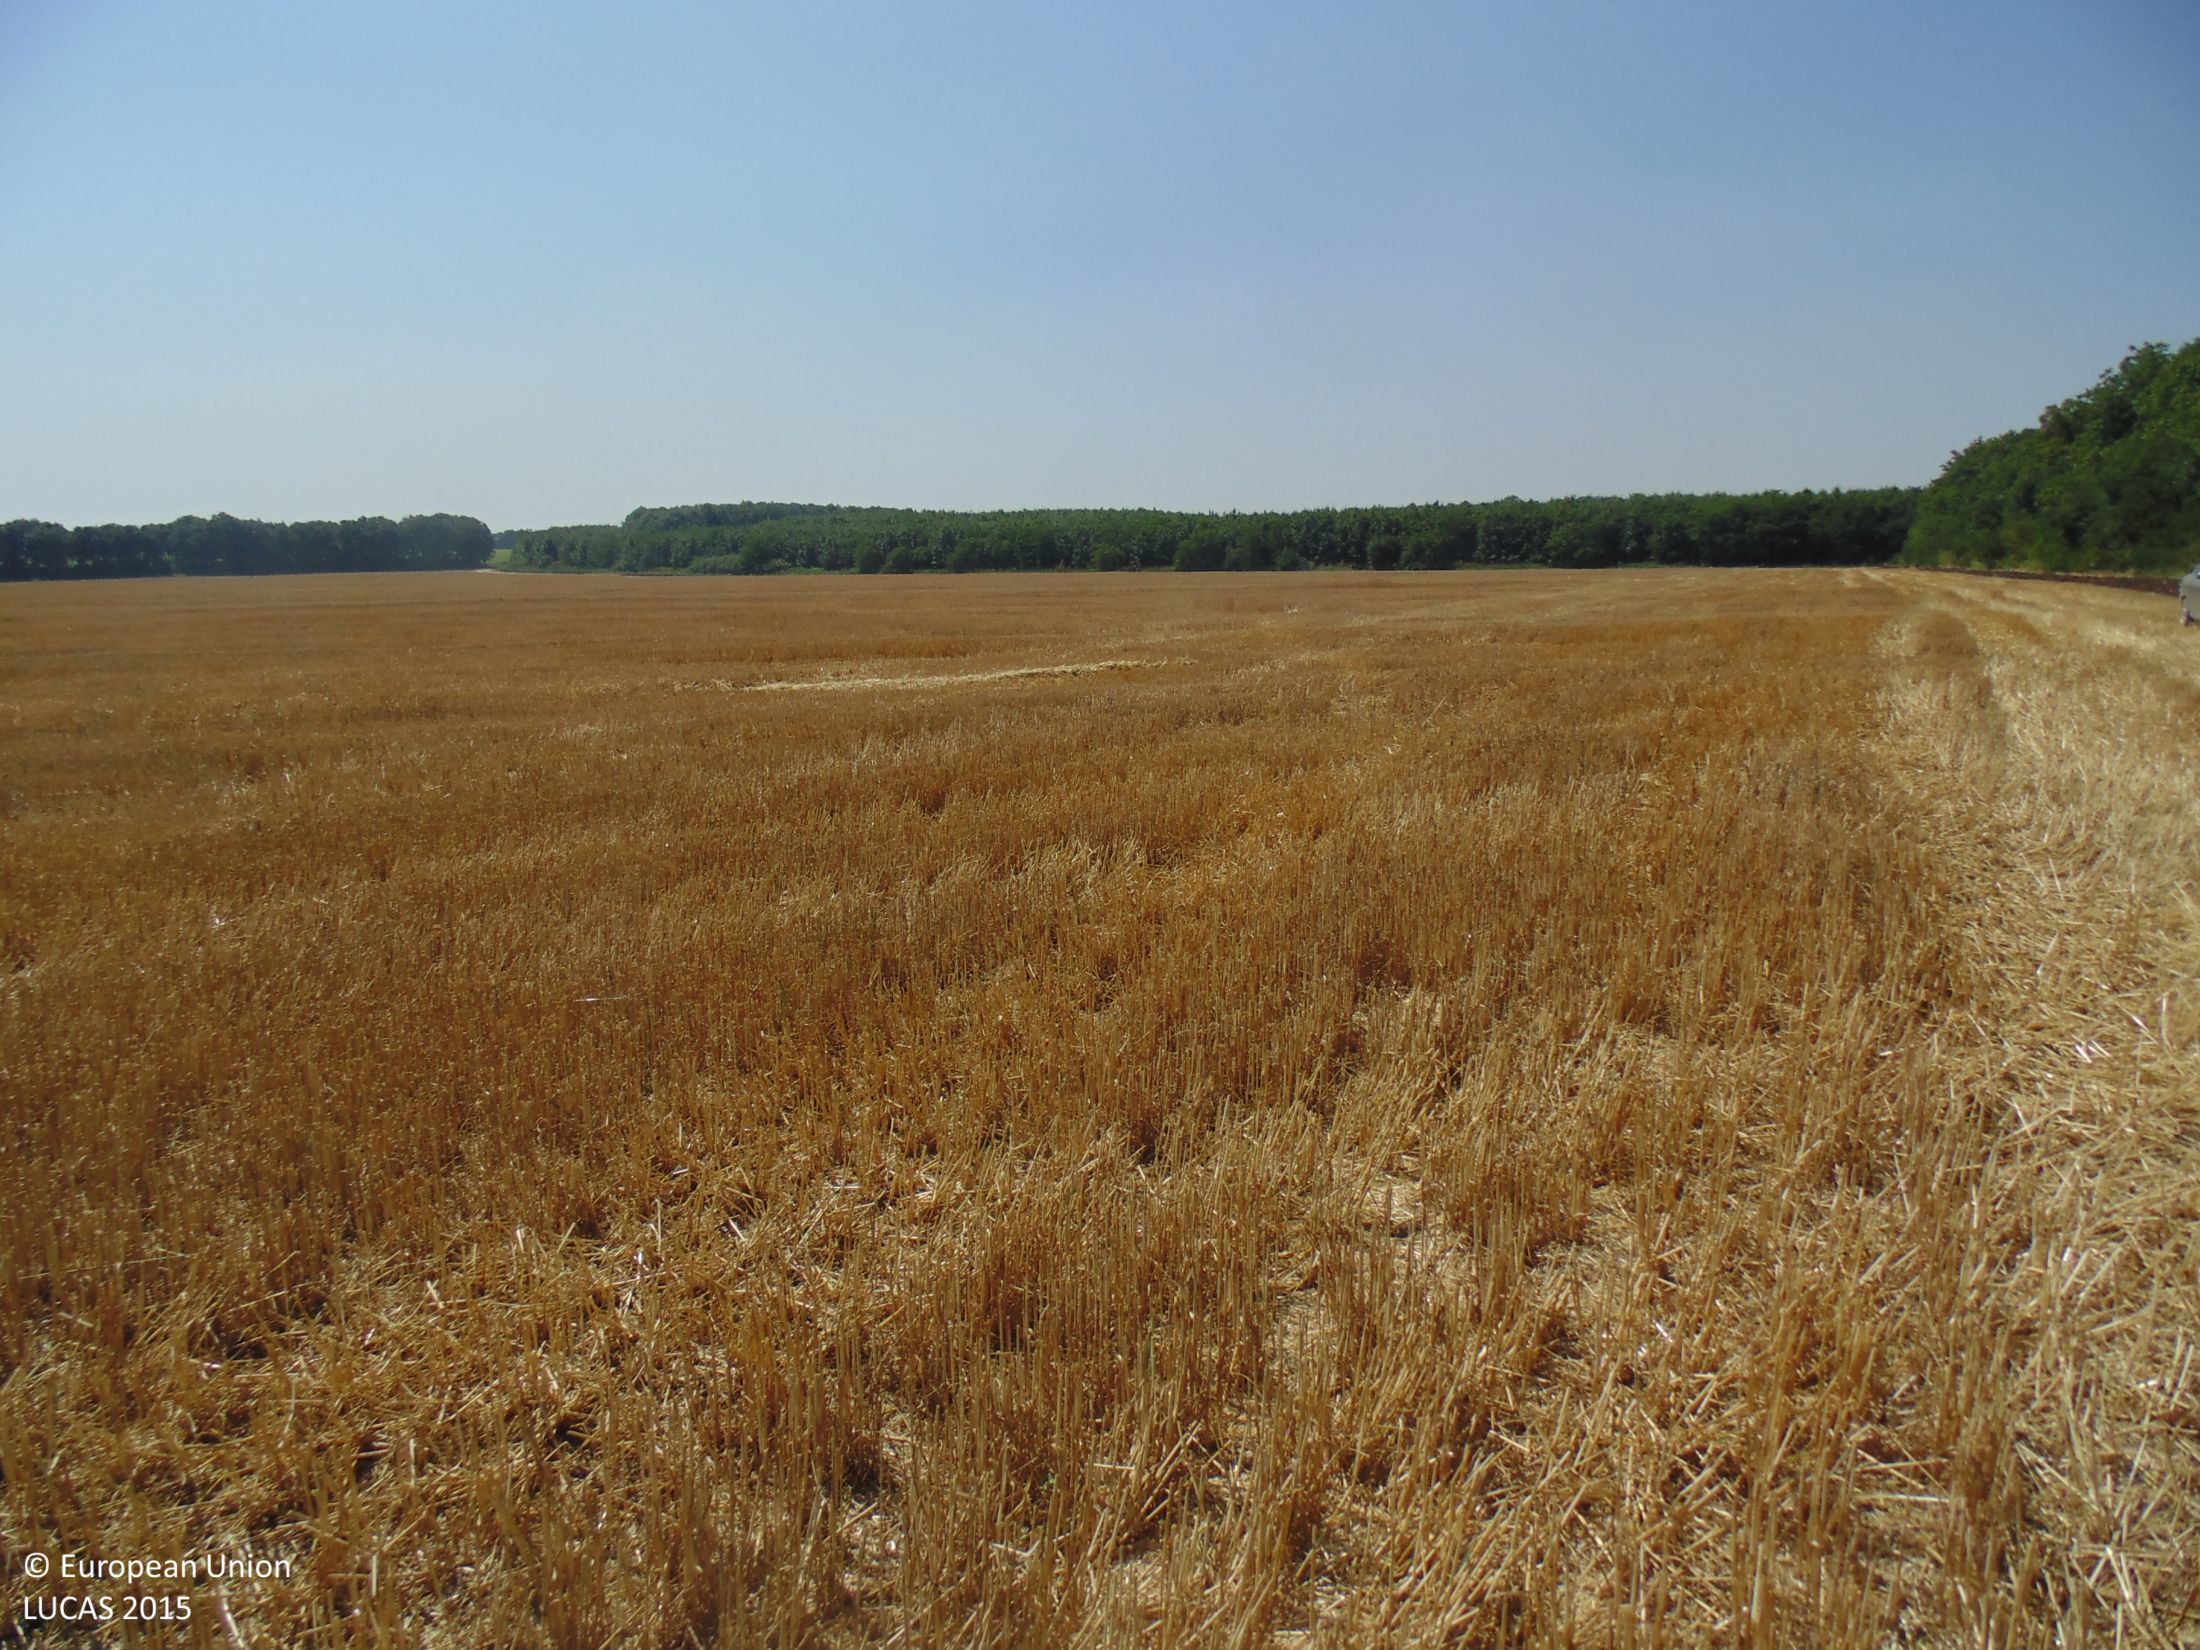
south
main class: Cropland
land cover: Common wheat
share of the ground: > 75 %
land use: Agriculture (excluding fallow land and kitchen gardens)
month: July
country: BG
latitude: 43.6644
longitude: 27.6861
